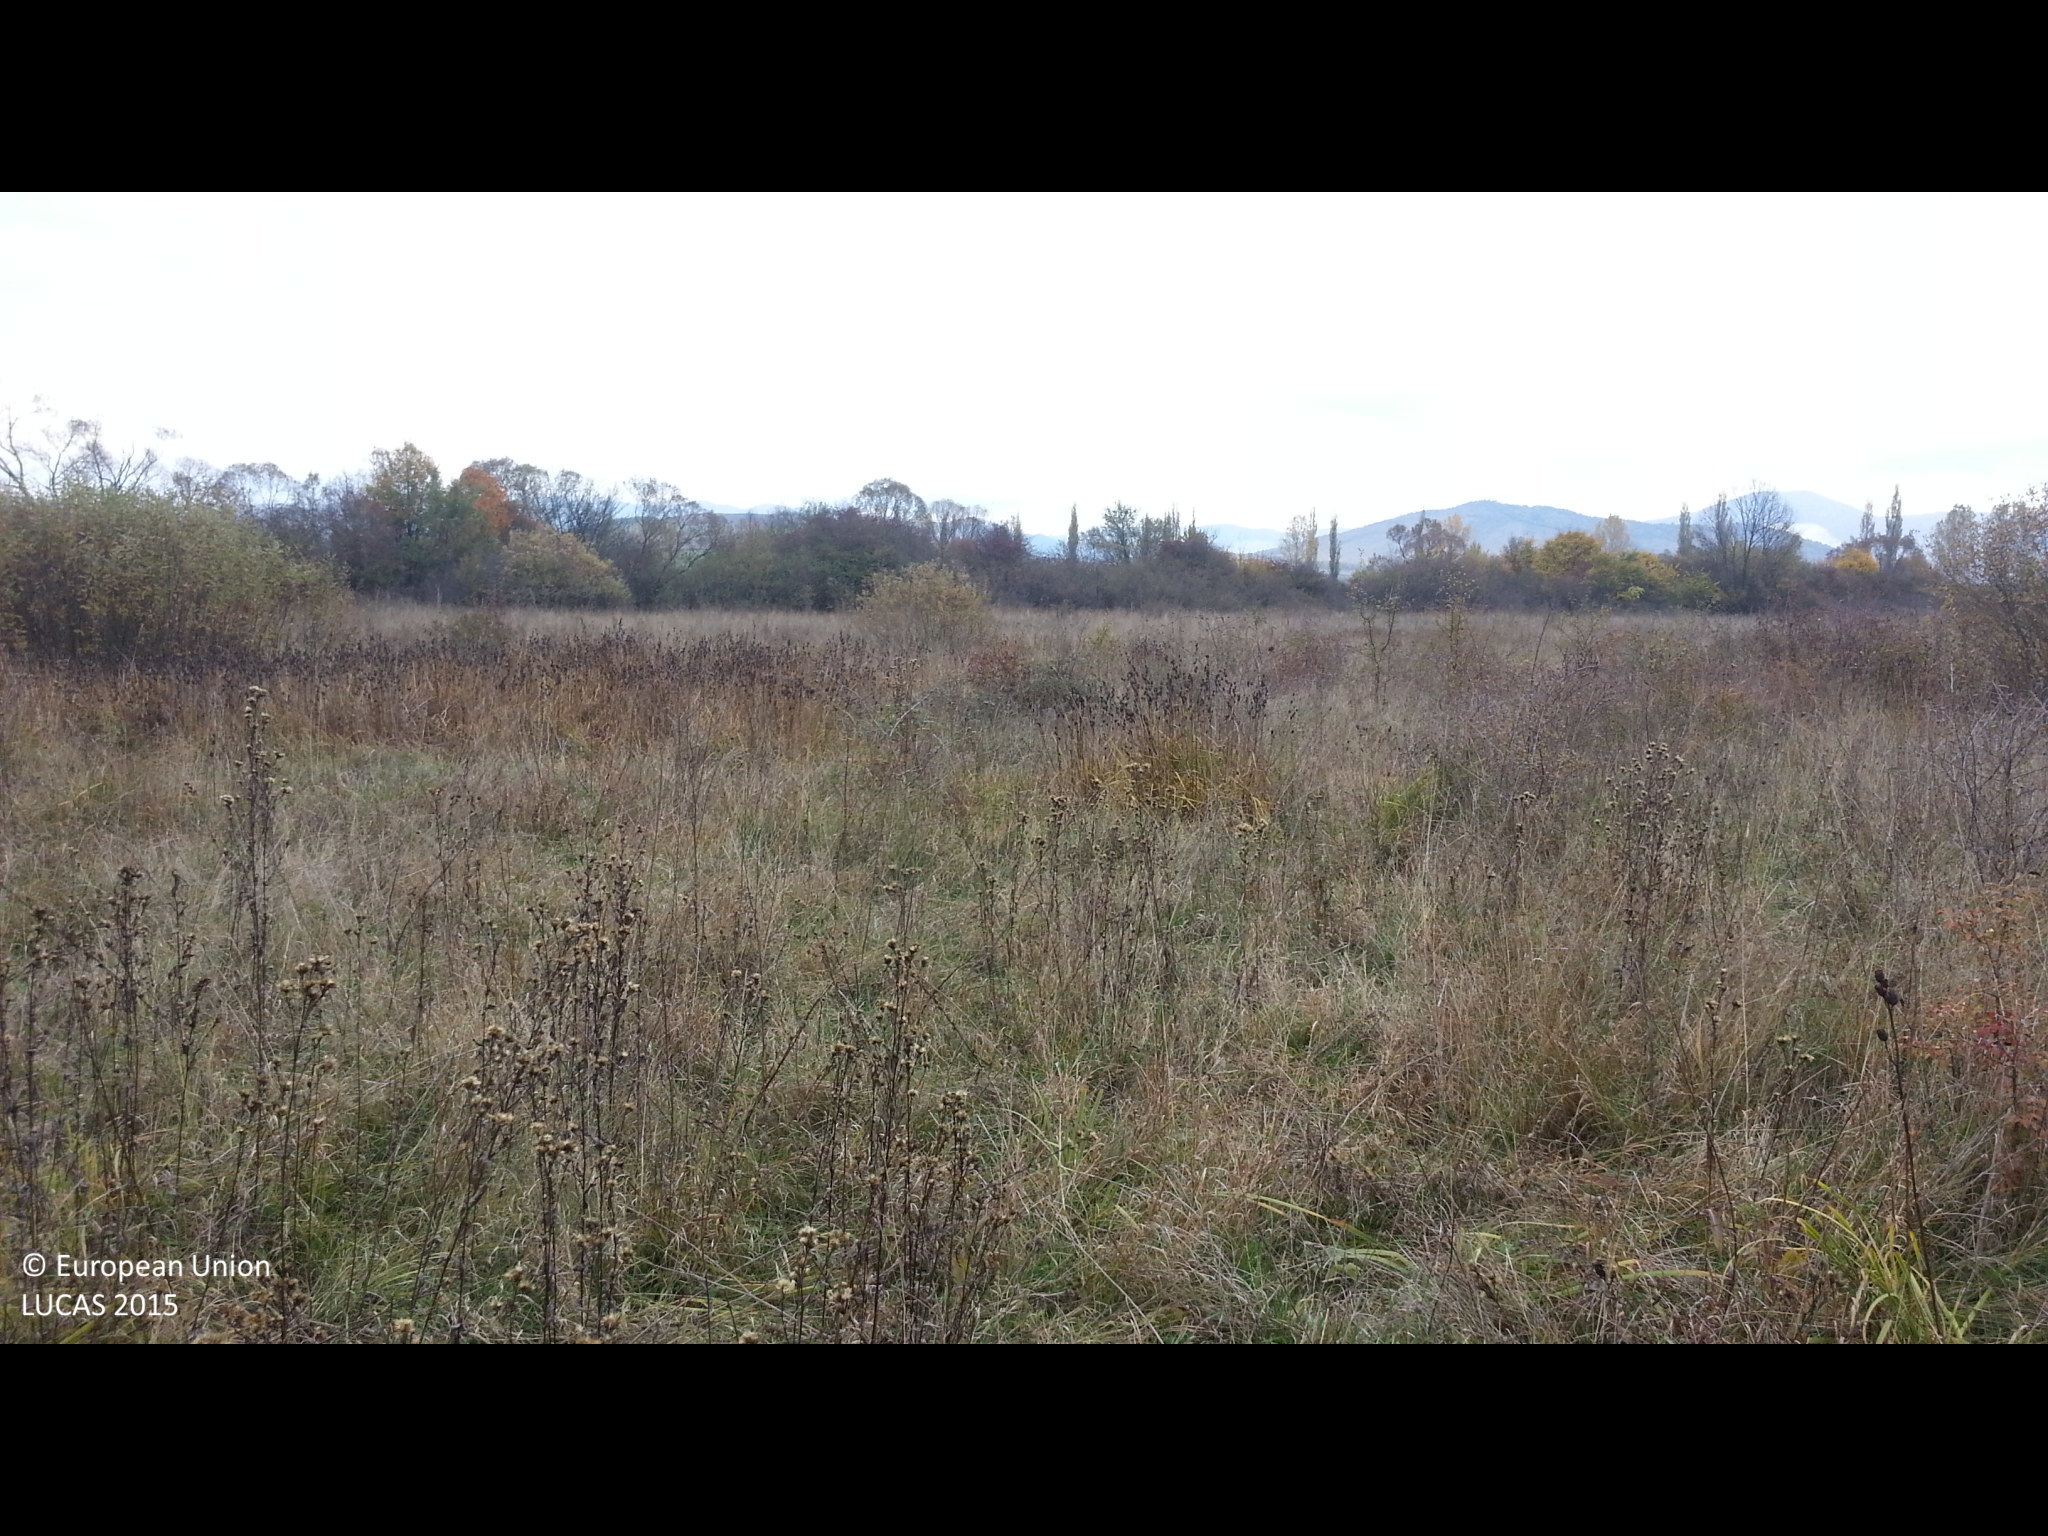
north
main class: Grassland
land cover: Grassland without tree/shrub cover
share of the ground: > 75 %
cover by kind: herbaceous plants 100 %
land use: Agriculture (excluding fallow land and kitchen gardens)
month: October
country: BG
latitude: 42.9215
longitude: 23.7272
